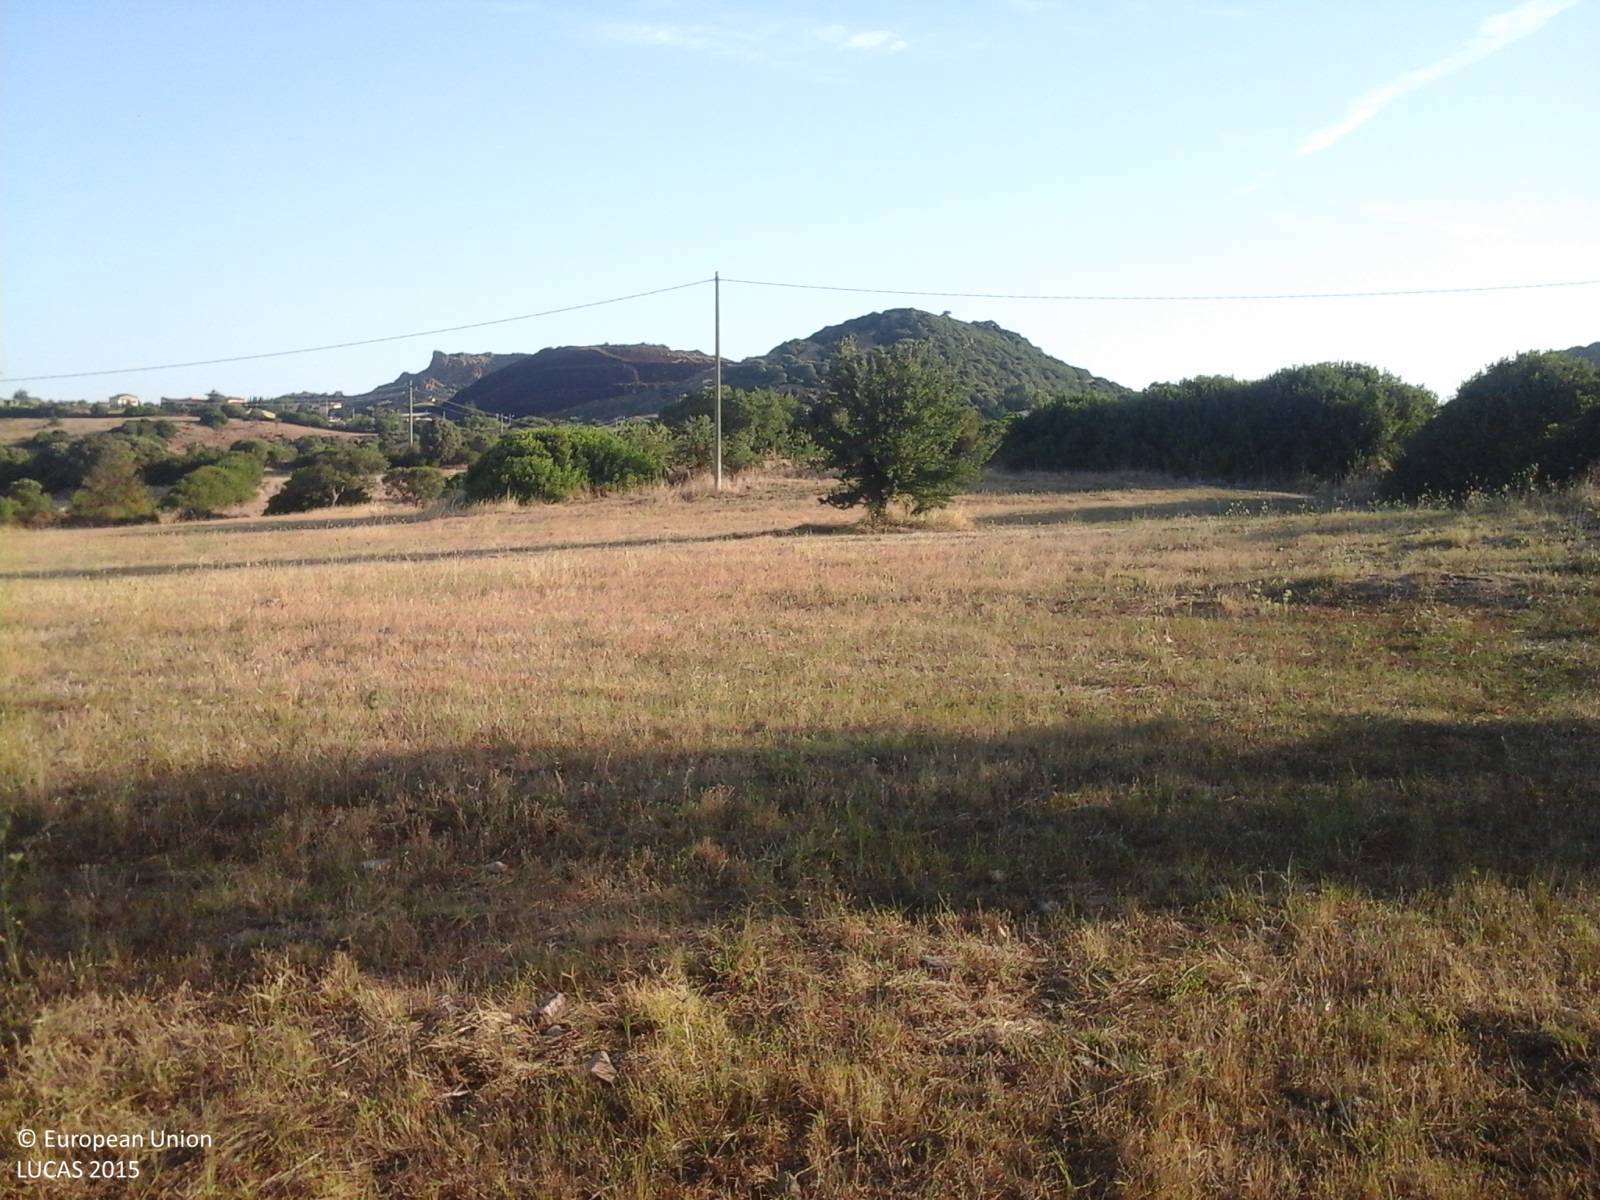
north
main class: Grassland
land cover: Grassland without tree/shrub cover
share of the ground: 10 - 25 %
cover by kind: herbaceous plants 100 %
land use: Agriculture (excluding fallow land and kitchen gardens)
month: July
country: IT
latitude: 40.5328
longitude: 8.9076
